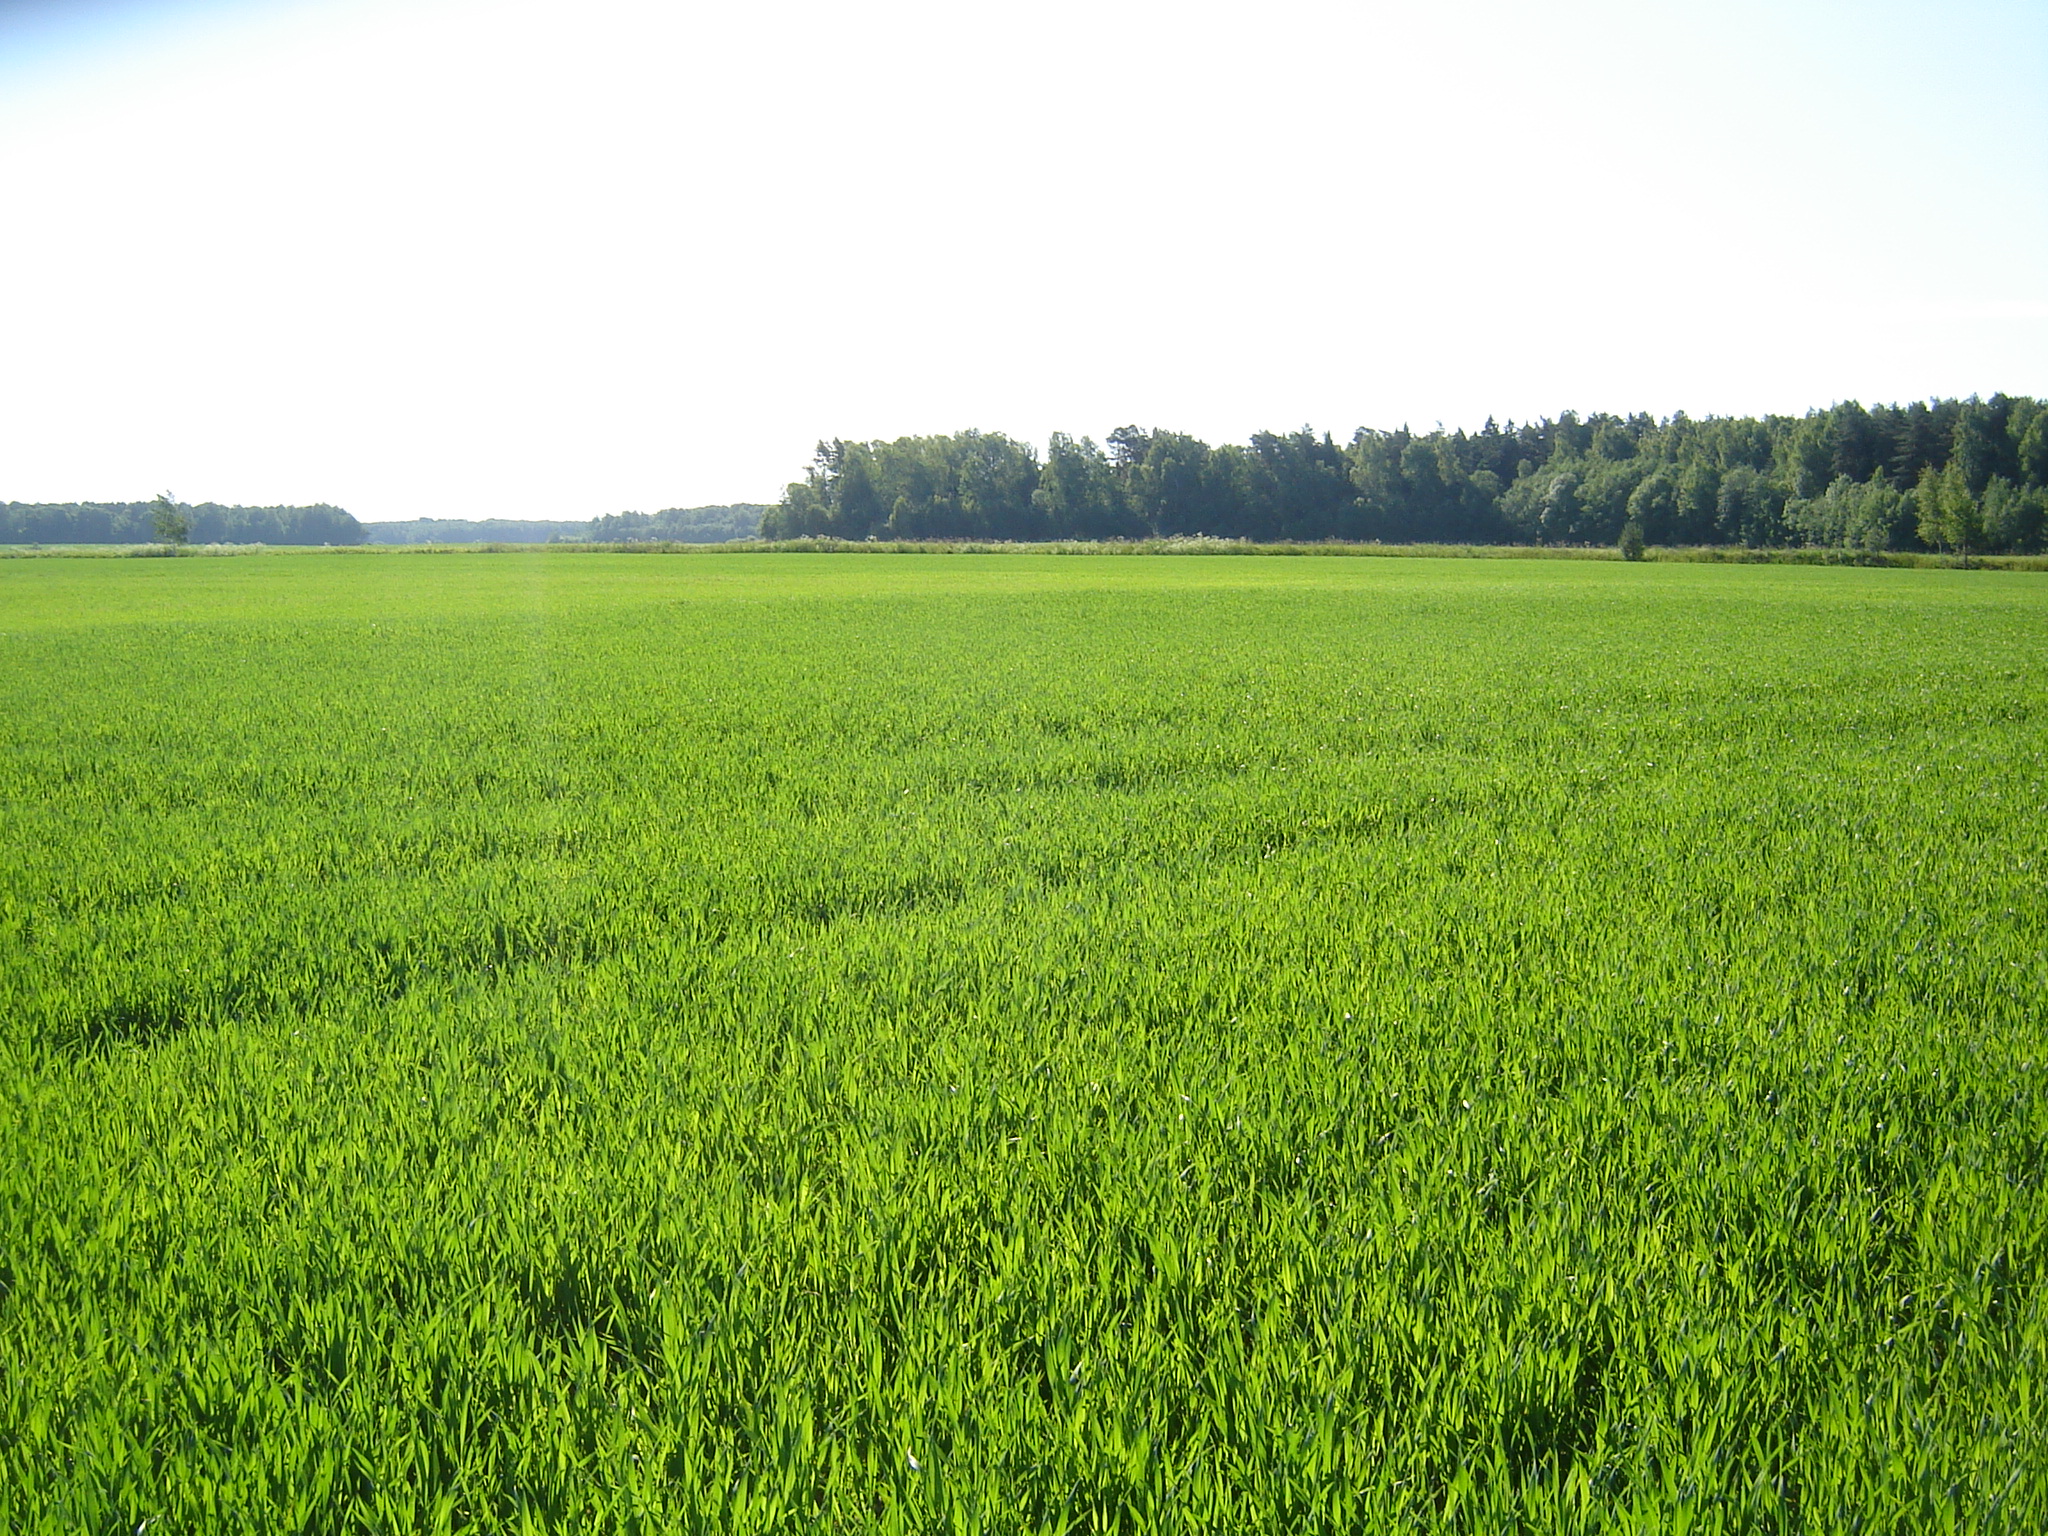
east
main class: Cropland
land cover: Common wheat
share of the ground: > 75 %
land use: Agriculture (excluding fallow land and kitchen gardens)
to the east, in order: Common wheat; Shruby margins; Paved roads, cycling and walking lanes; Shruby margins; Common wheat
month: June
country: LT
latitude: 55.5252
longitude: 24.7912
